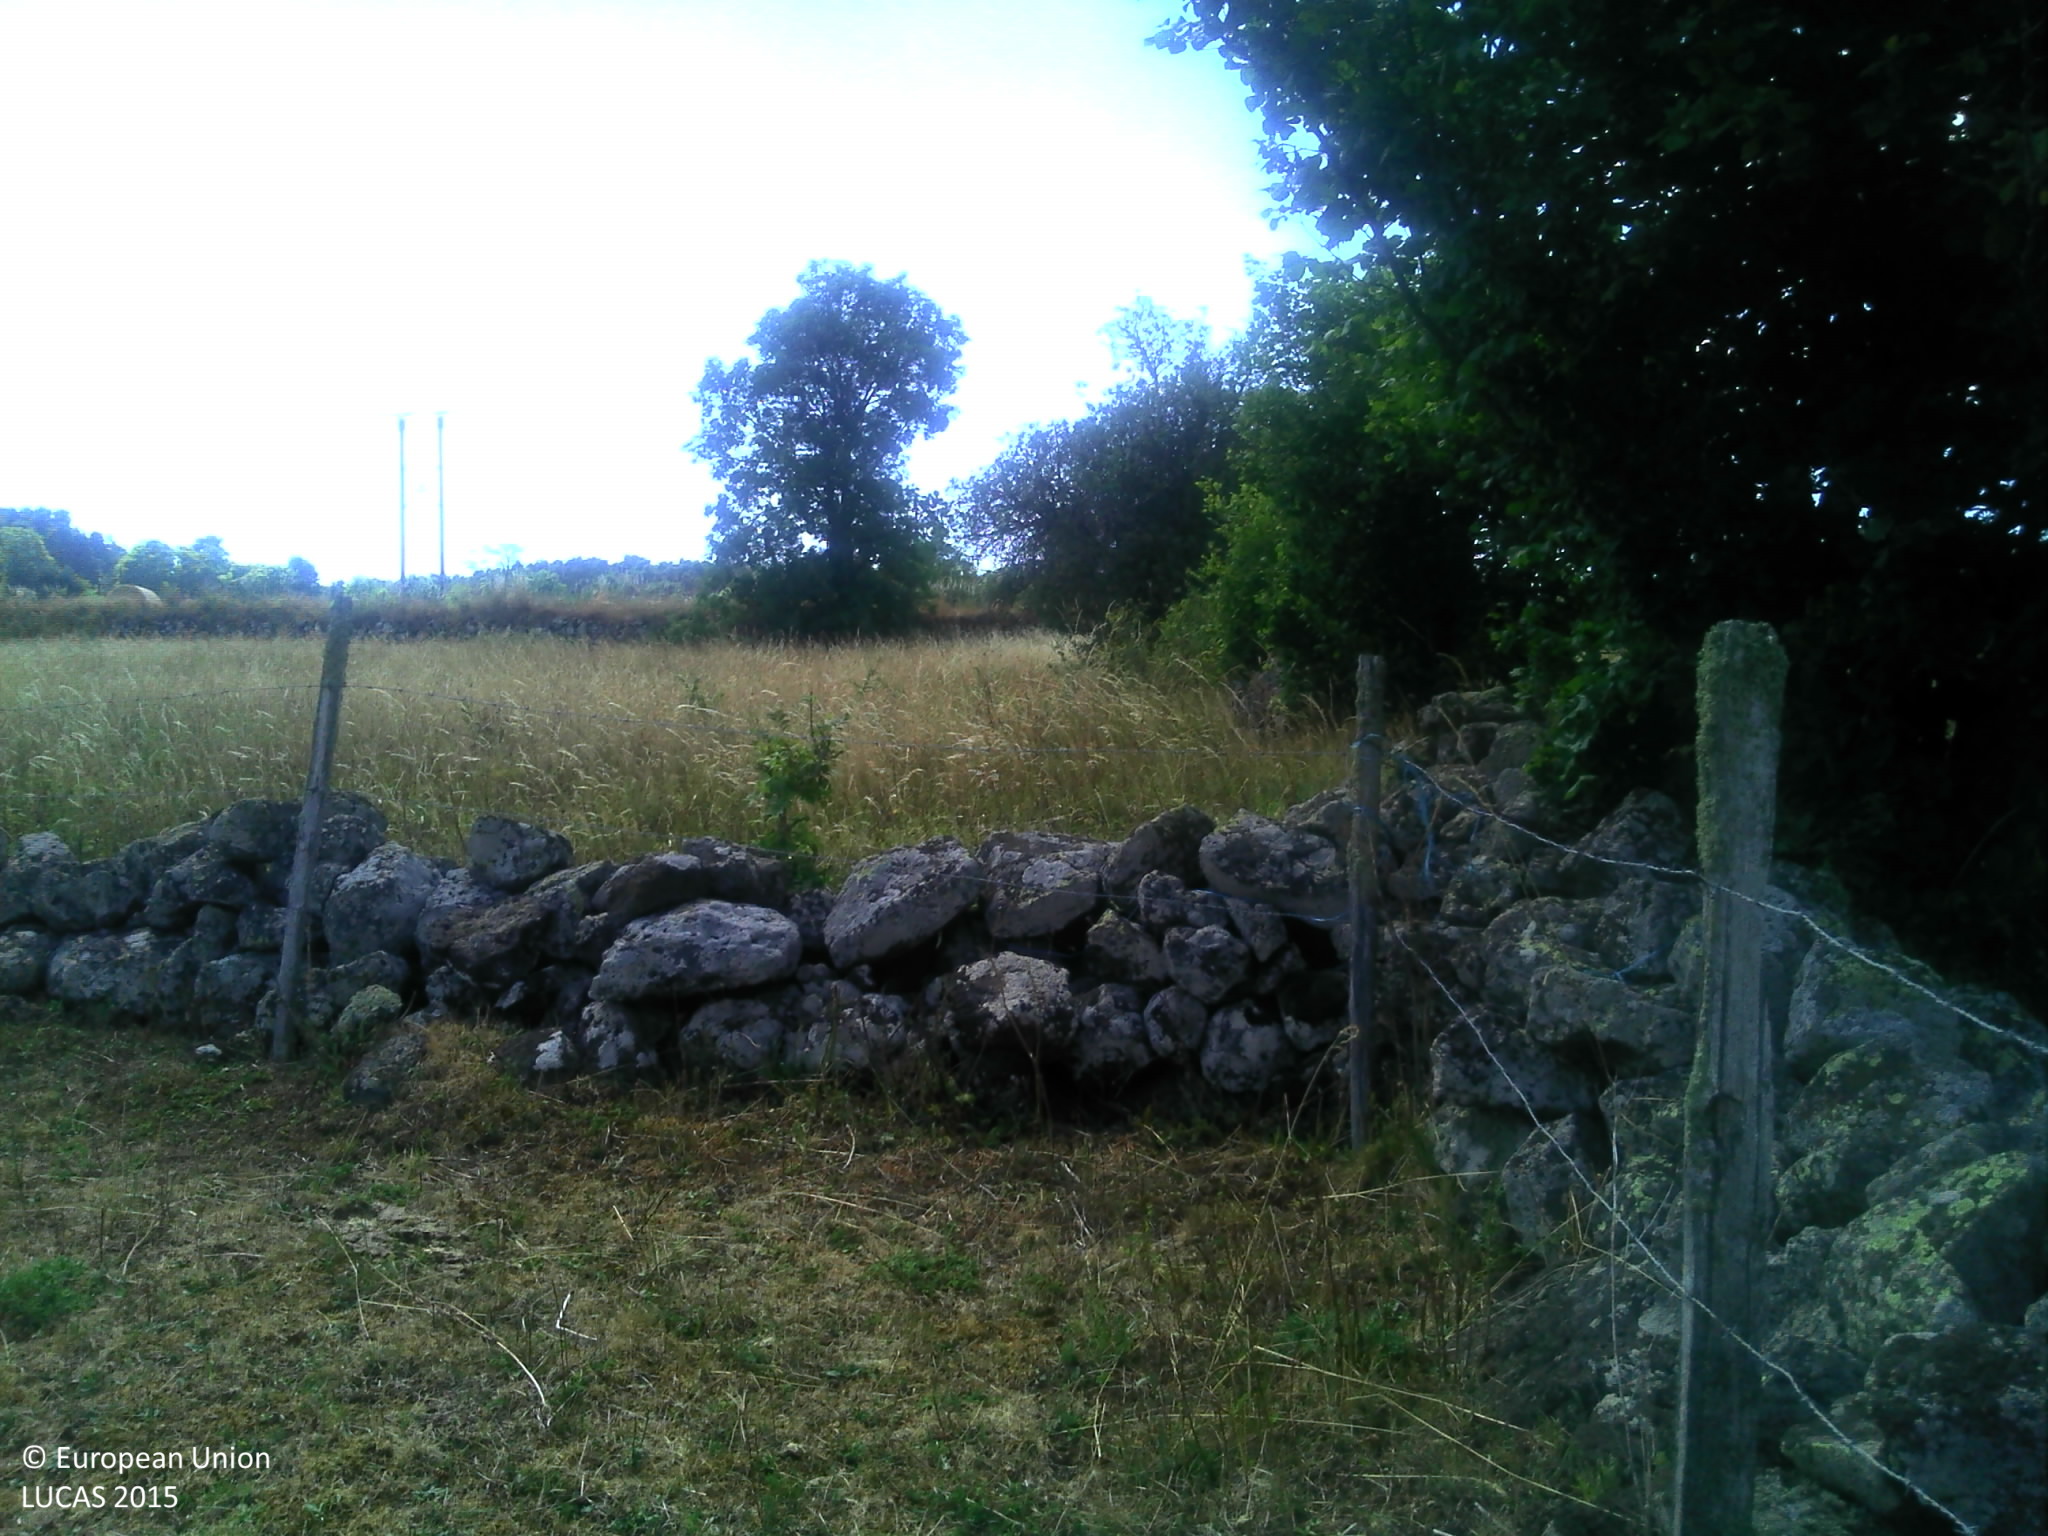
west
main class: Grassland
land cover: Grassland without tree/shrub cover
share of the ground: > 75 %
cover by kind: herbaceous plants 100 %
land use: Agriculture (excluding fallow land and kitchen gardens)
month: July
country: FR
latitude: 44.9265
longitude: 3.8343
